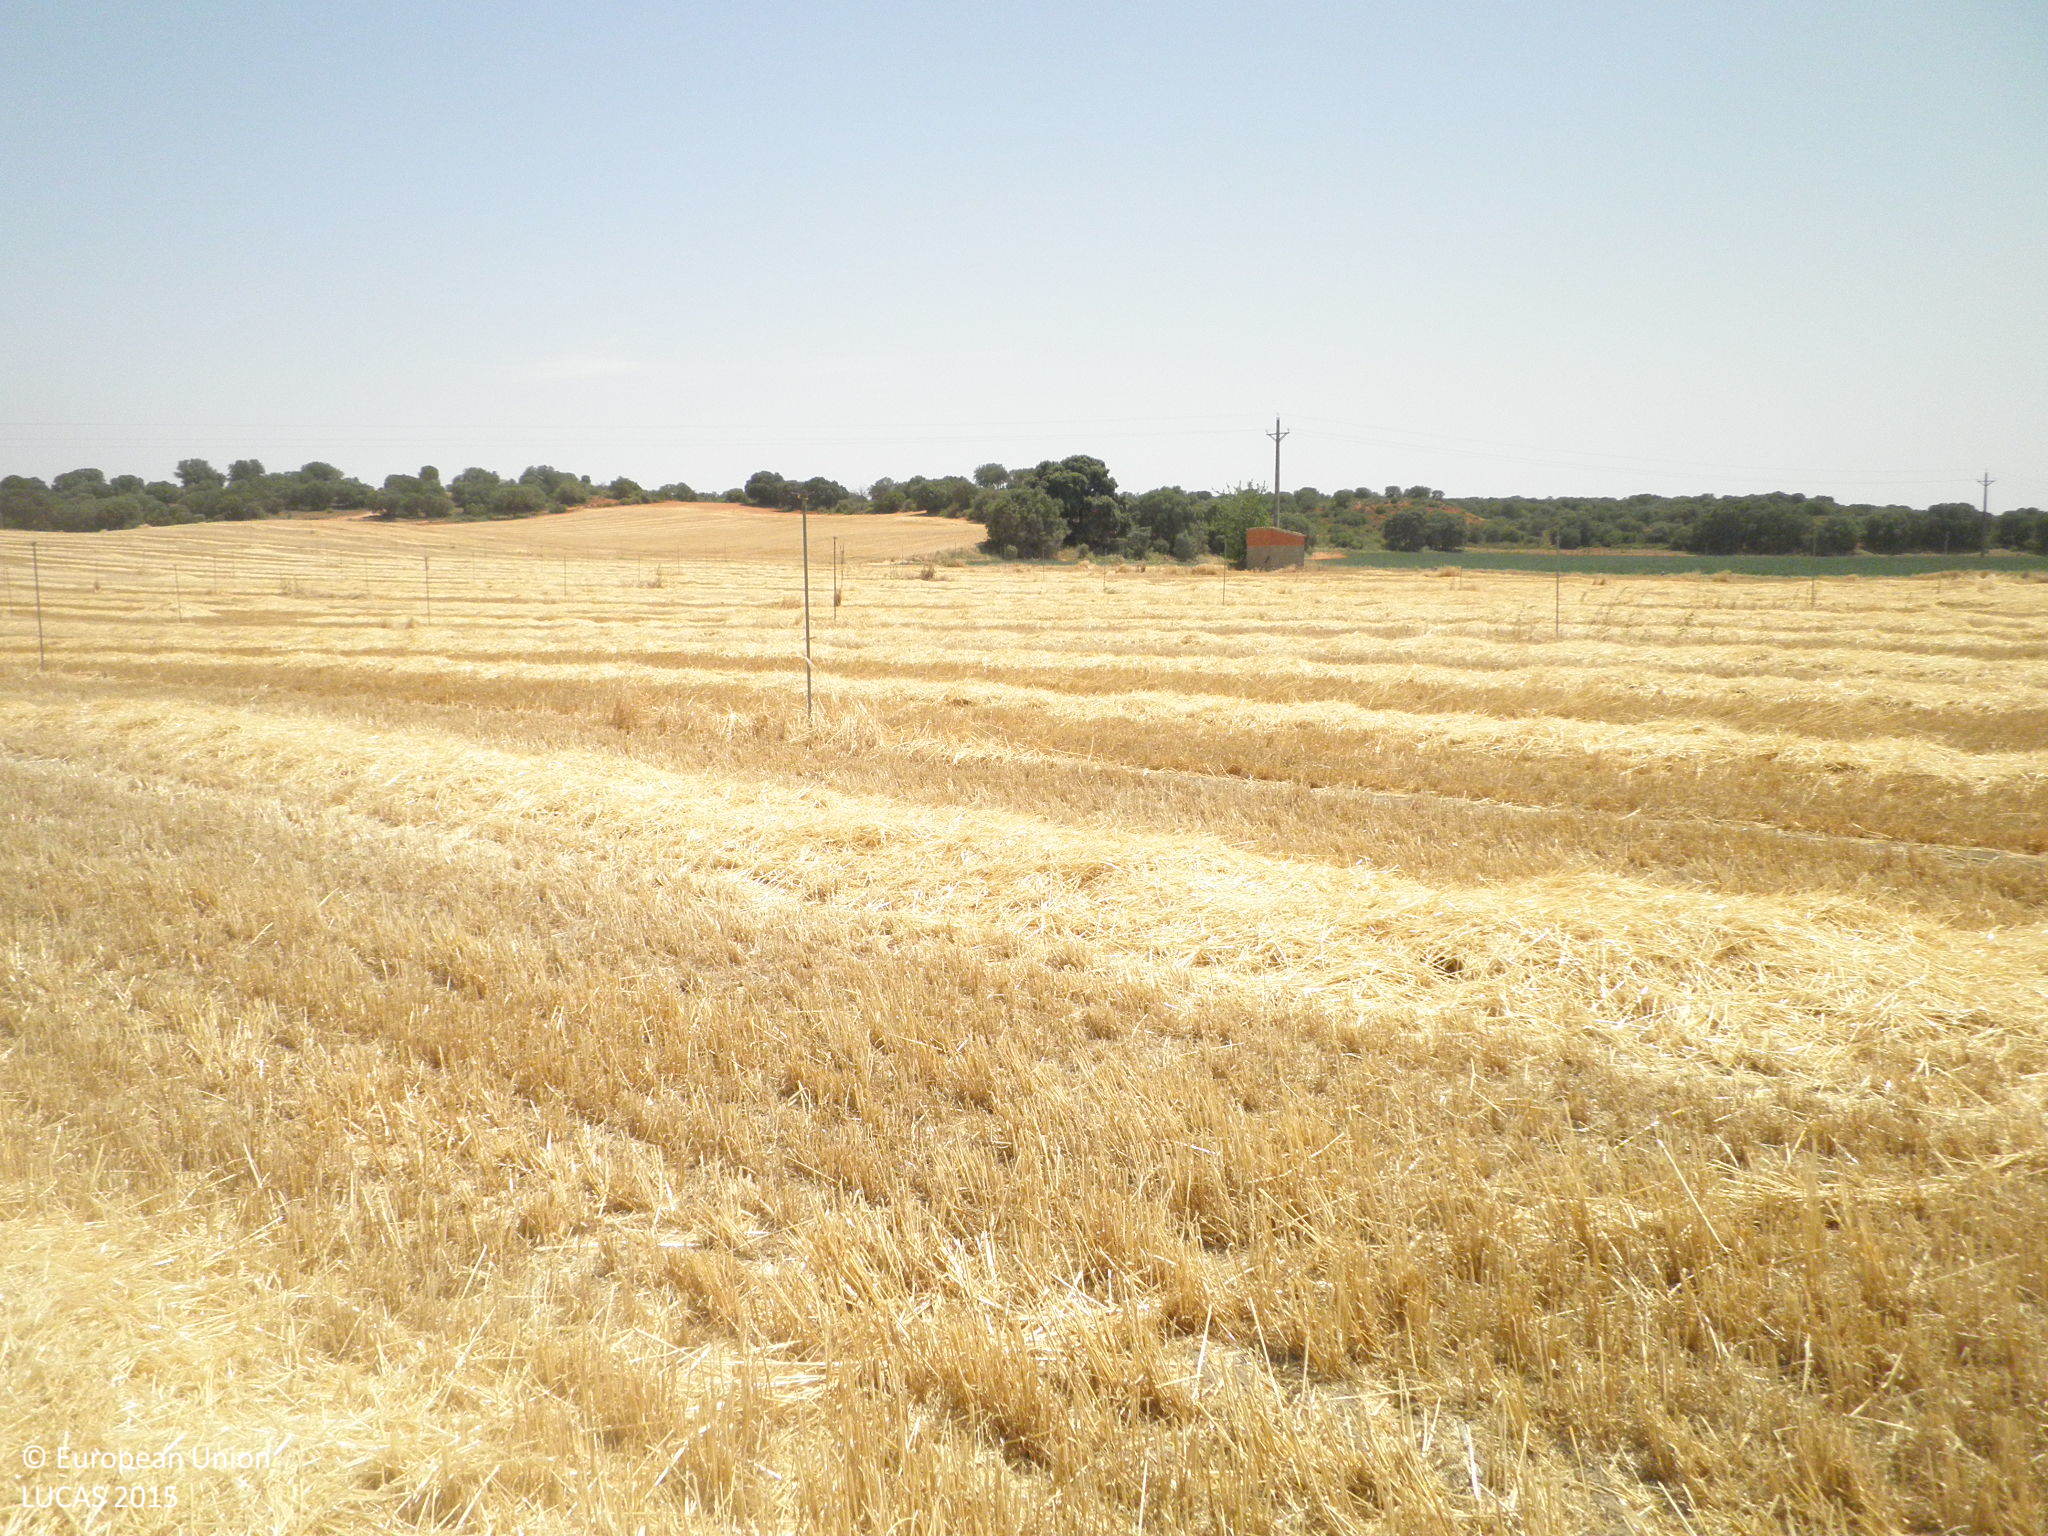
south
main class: Cropland
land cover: Barley
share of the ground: 50 - 75 %
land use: Agriculture (excluding fallow land and kitchen gardens)
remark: Harvested field
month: July
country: ES
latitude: 39.4547
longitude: -2.5750
